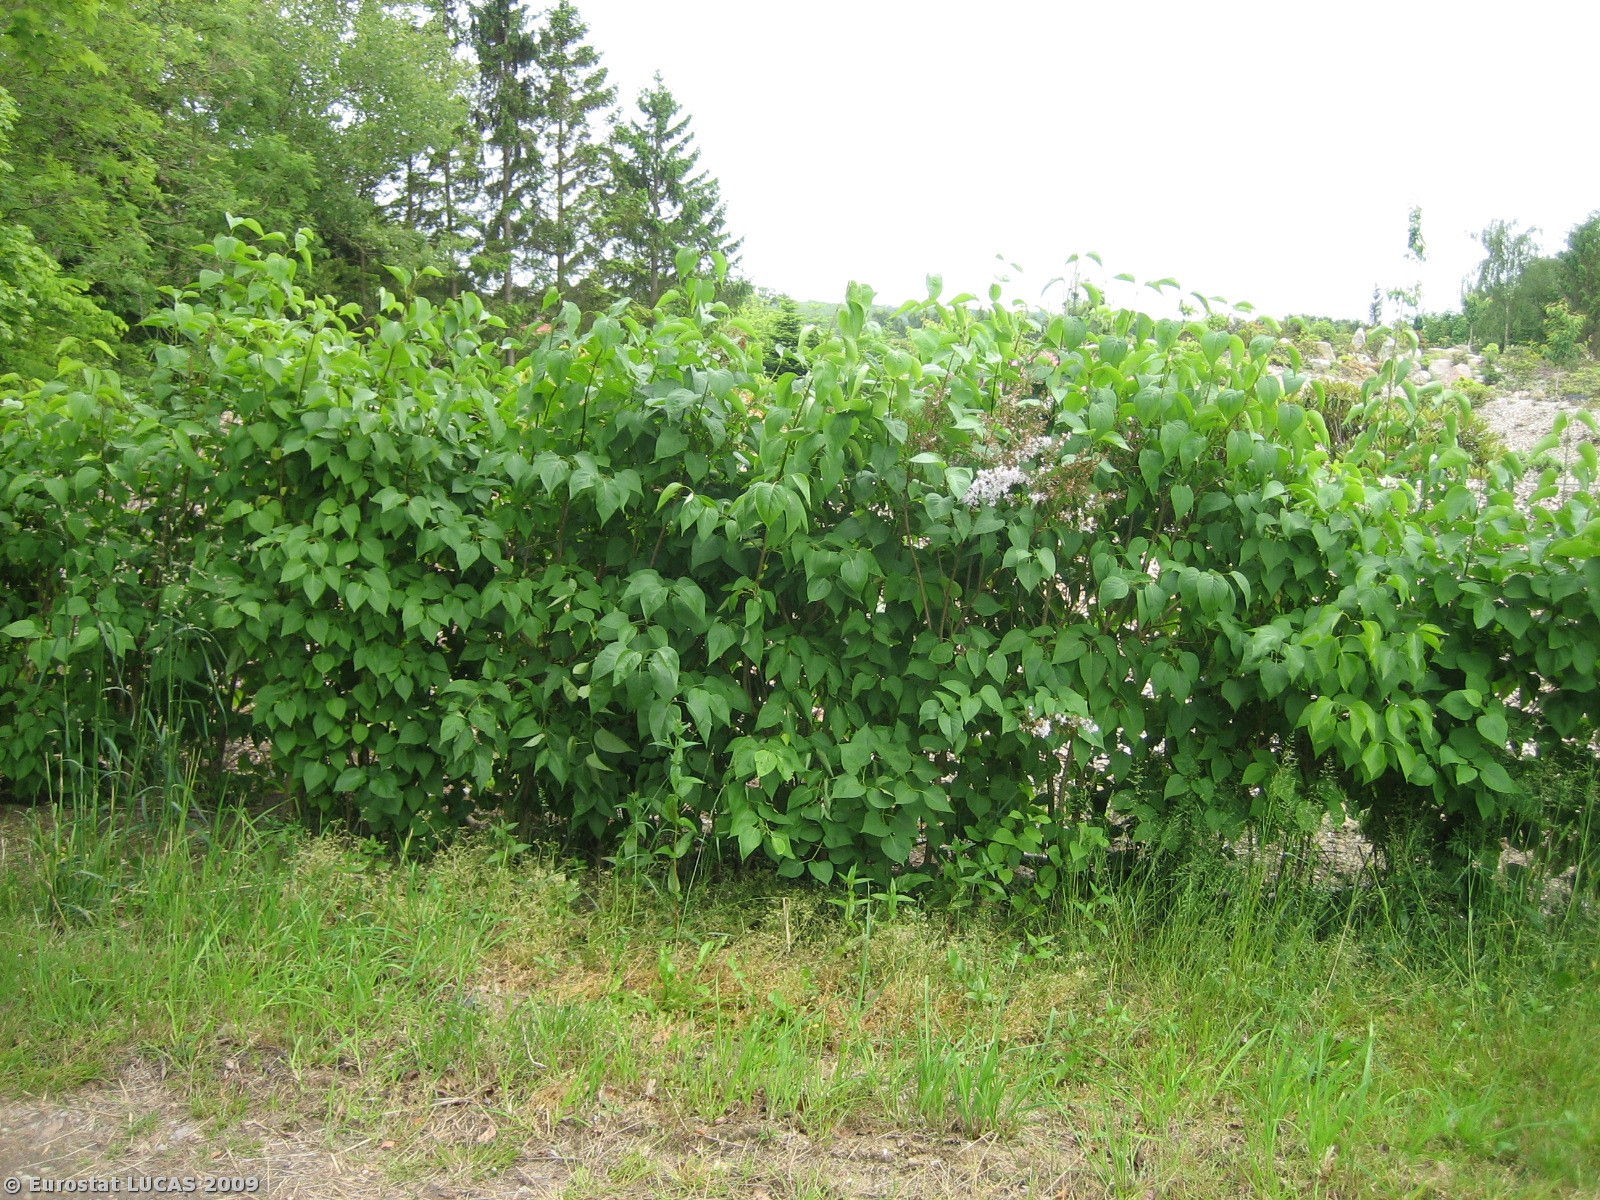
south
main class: Woodland
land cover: Broadleaved woodland
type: mesophytic deciduous forest
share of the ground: 50 - 75 %
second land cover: Grassland with sparse tree/shrub cover
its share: > 75 %
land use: Forestry
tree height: > 5 m
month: June
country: DK
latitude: 56.0798
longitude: 10.1123
